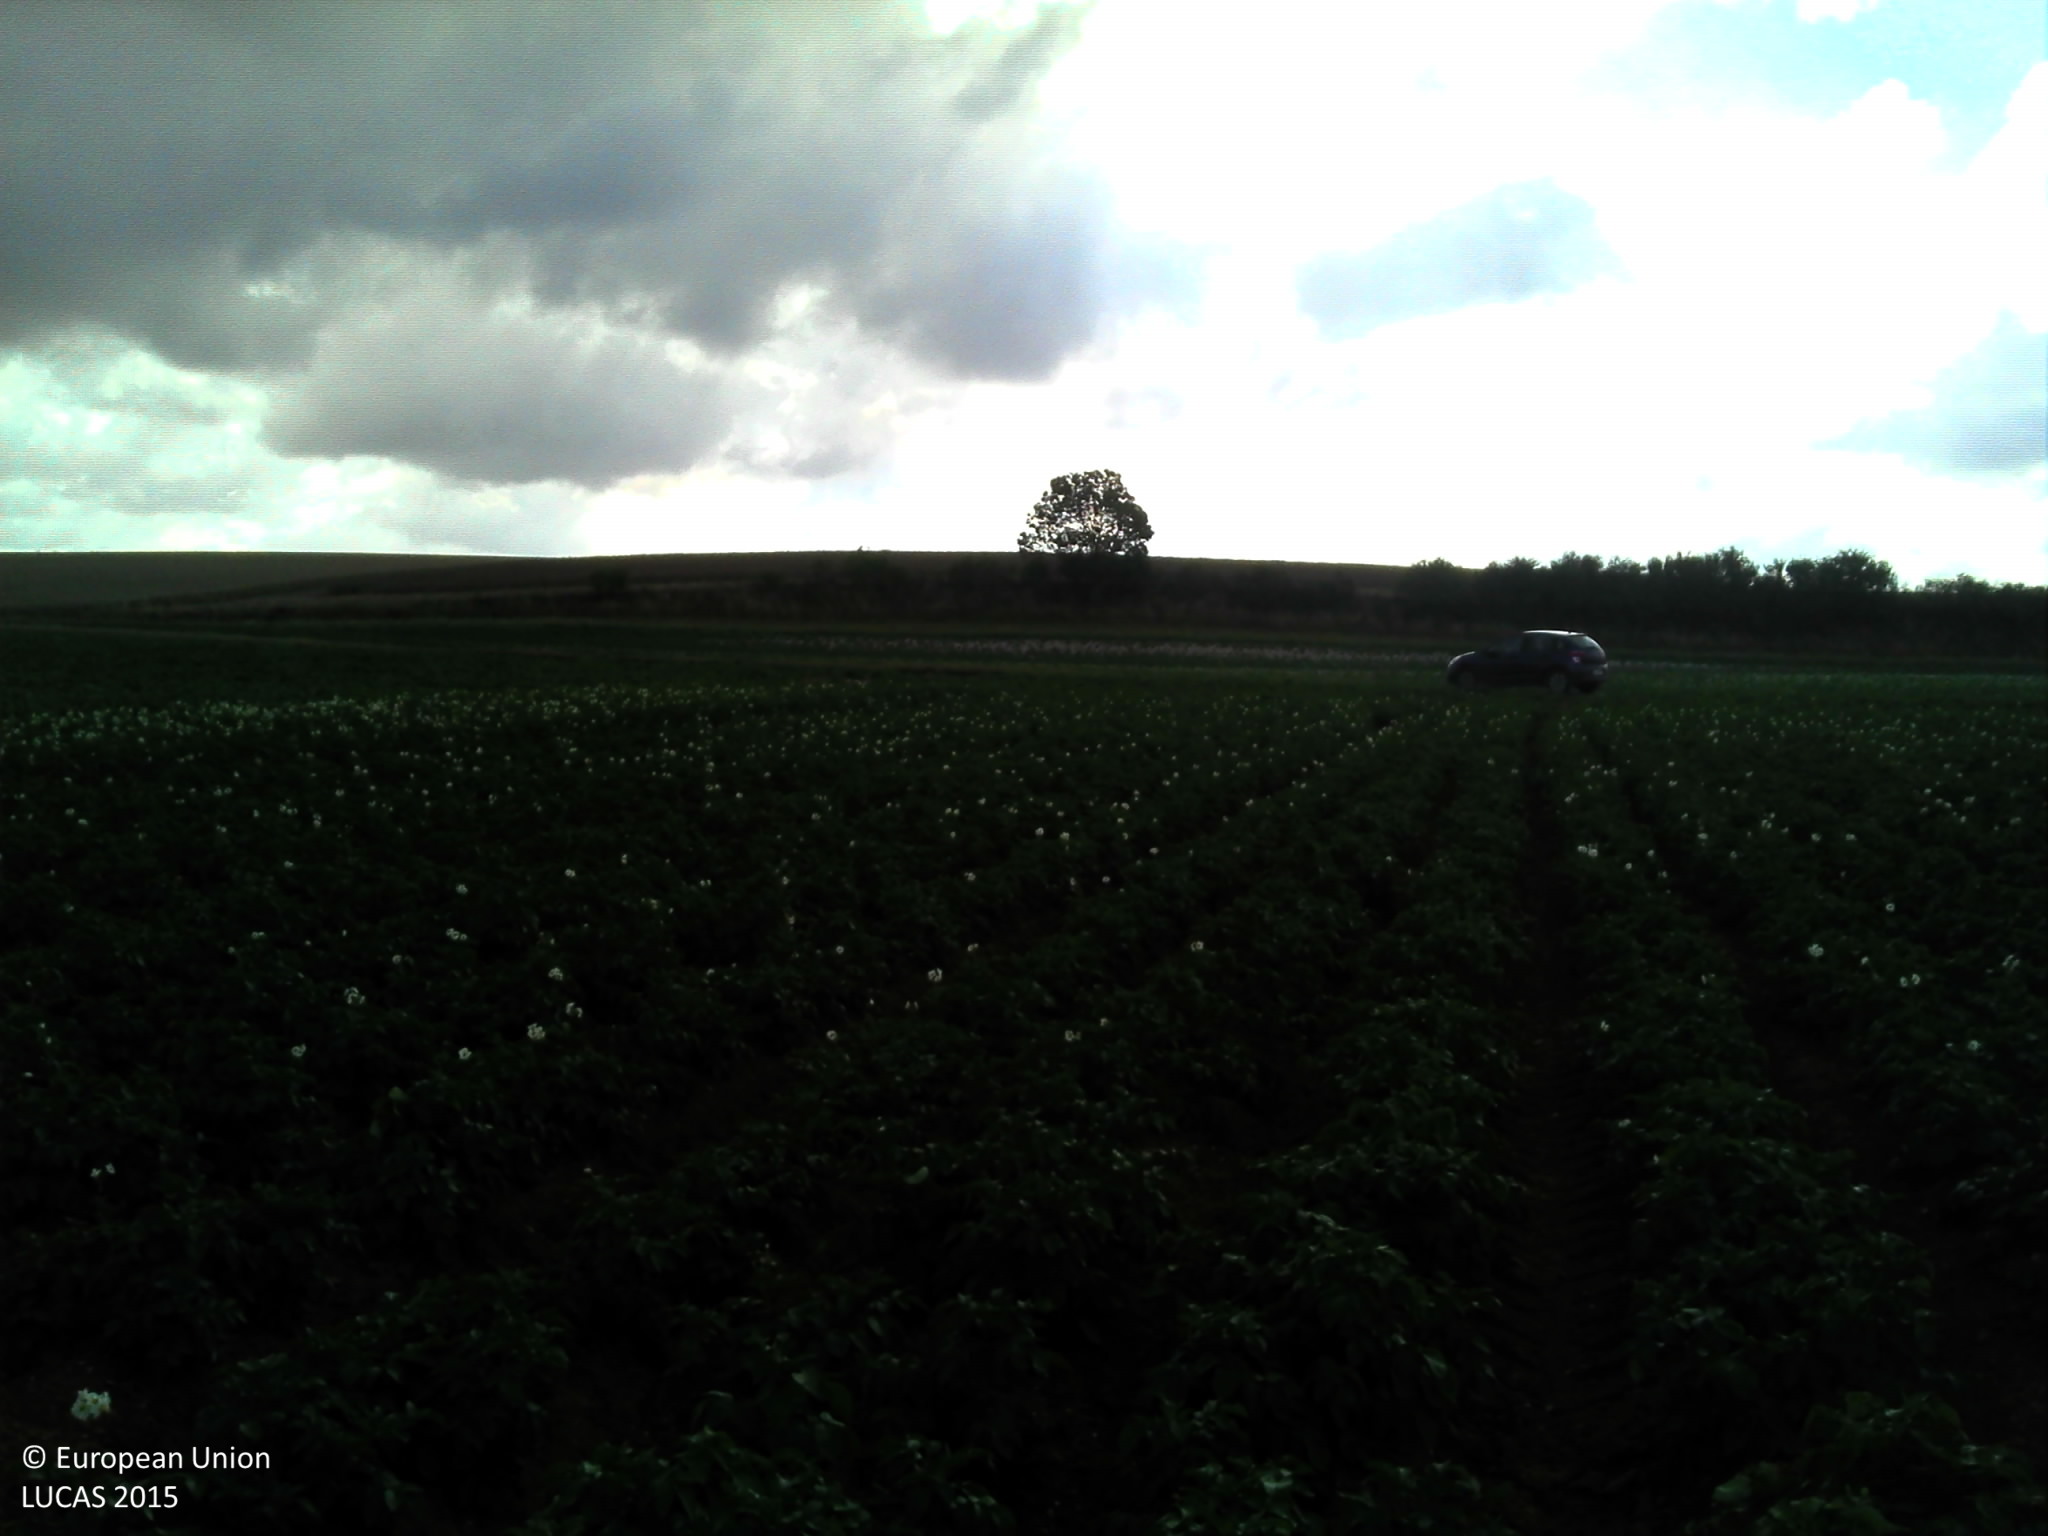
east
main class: Cropland
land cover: Potatoes
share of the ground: > 75 %
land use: Agriculture (excluding fallow land and kitchen gardens)
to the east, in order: Potatoes; Grass margins; Tracks; Grass margins; Potatoes; Grassland without tree/shrub cover; Abandoned hedges; Rape and turnip rape
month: July
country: FR
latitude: 50.0410
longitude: 2.4332
